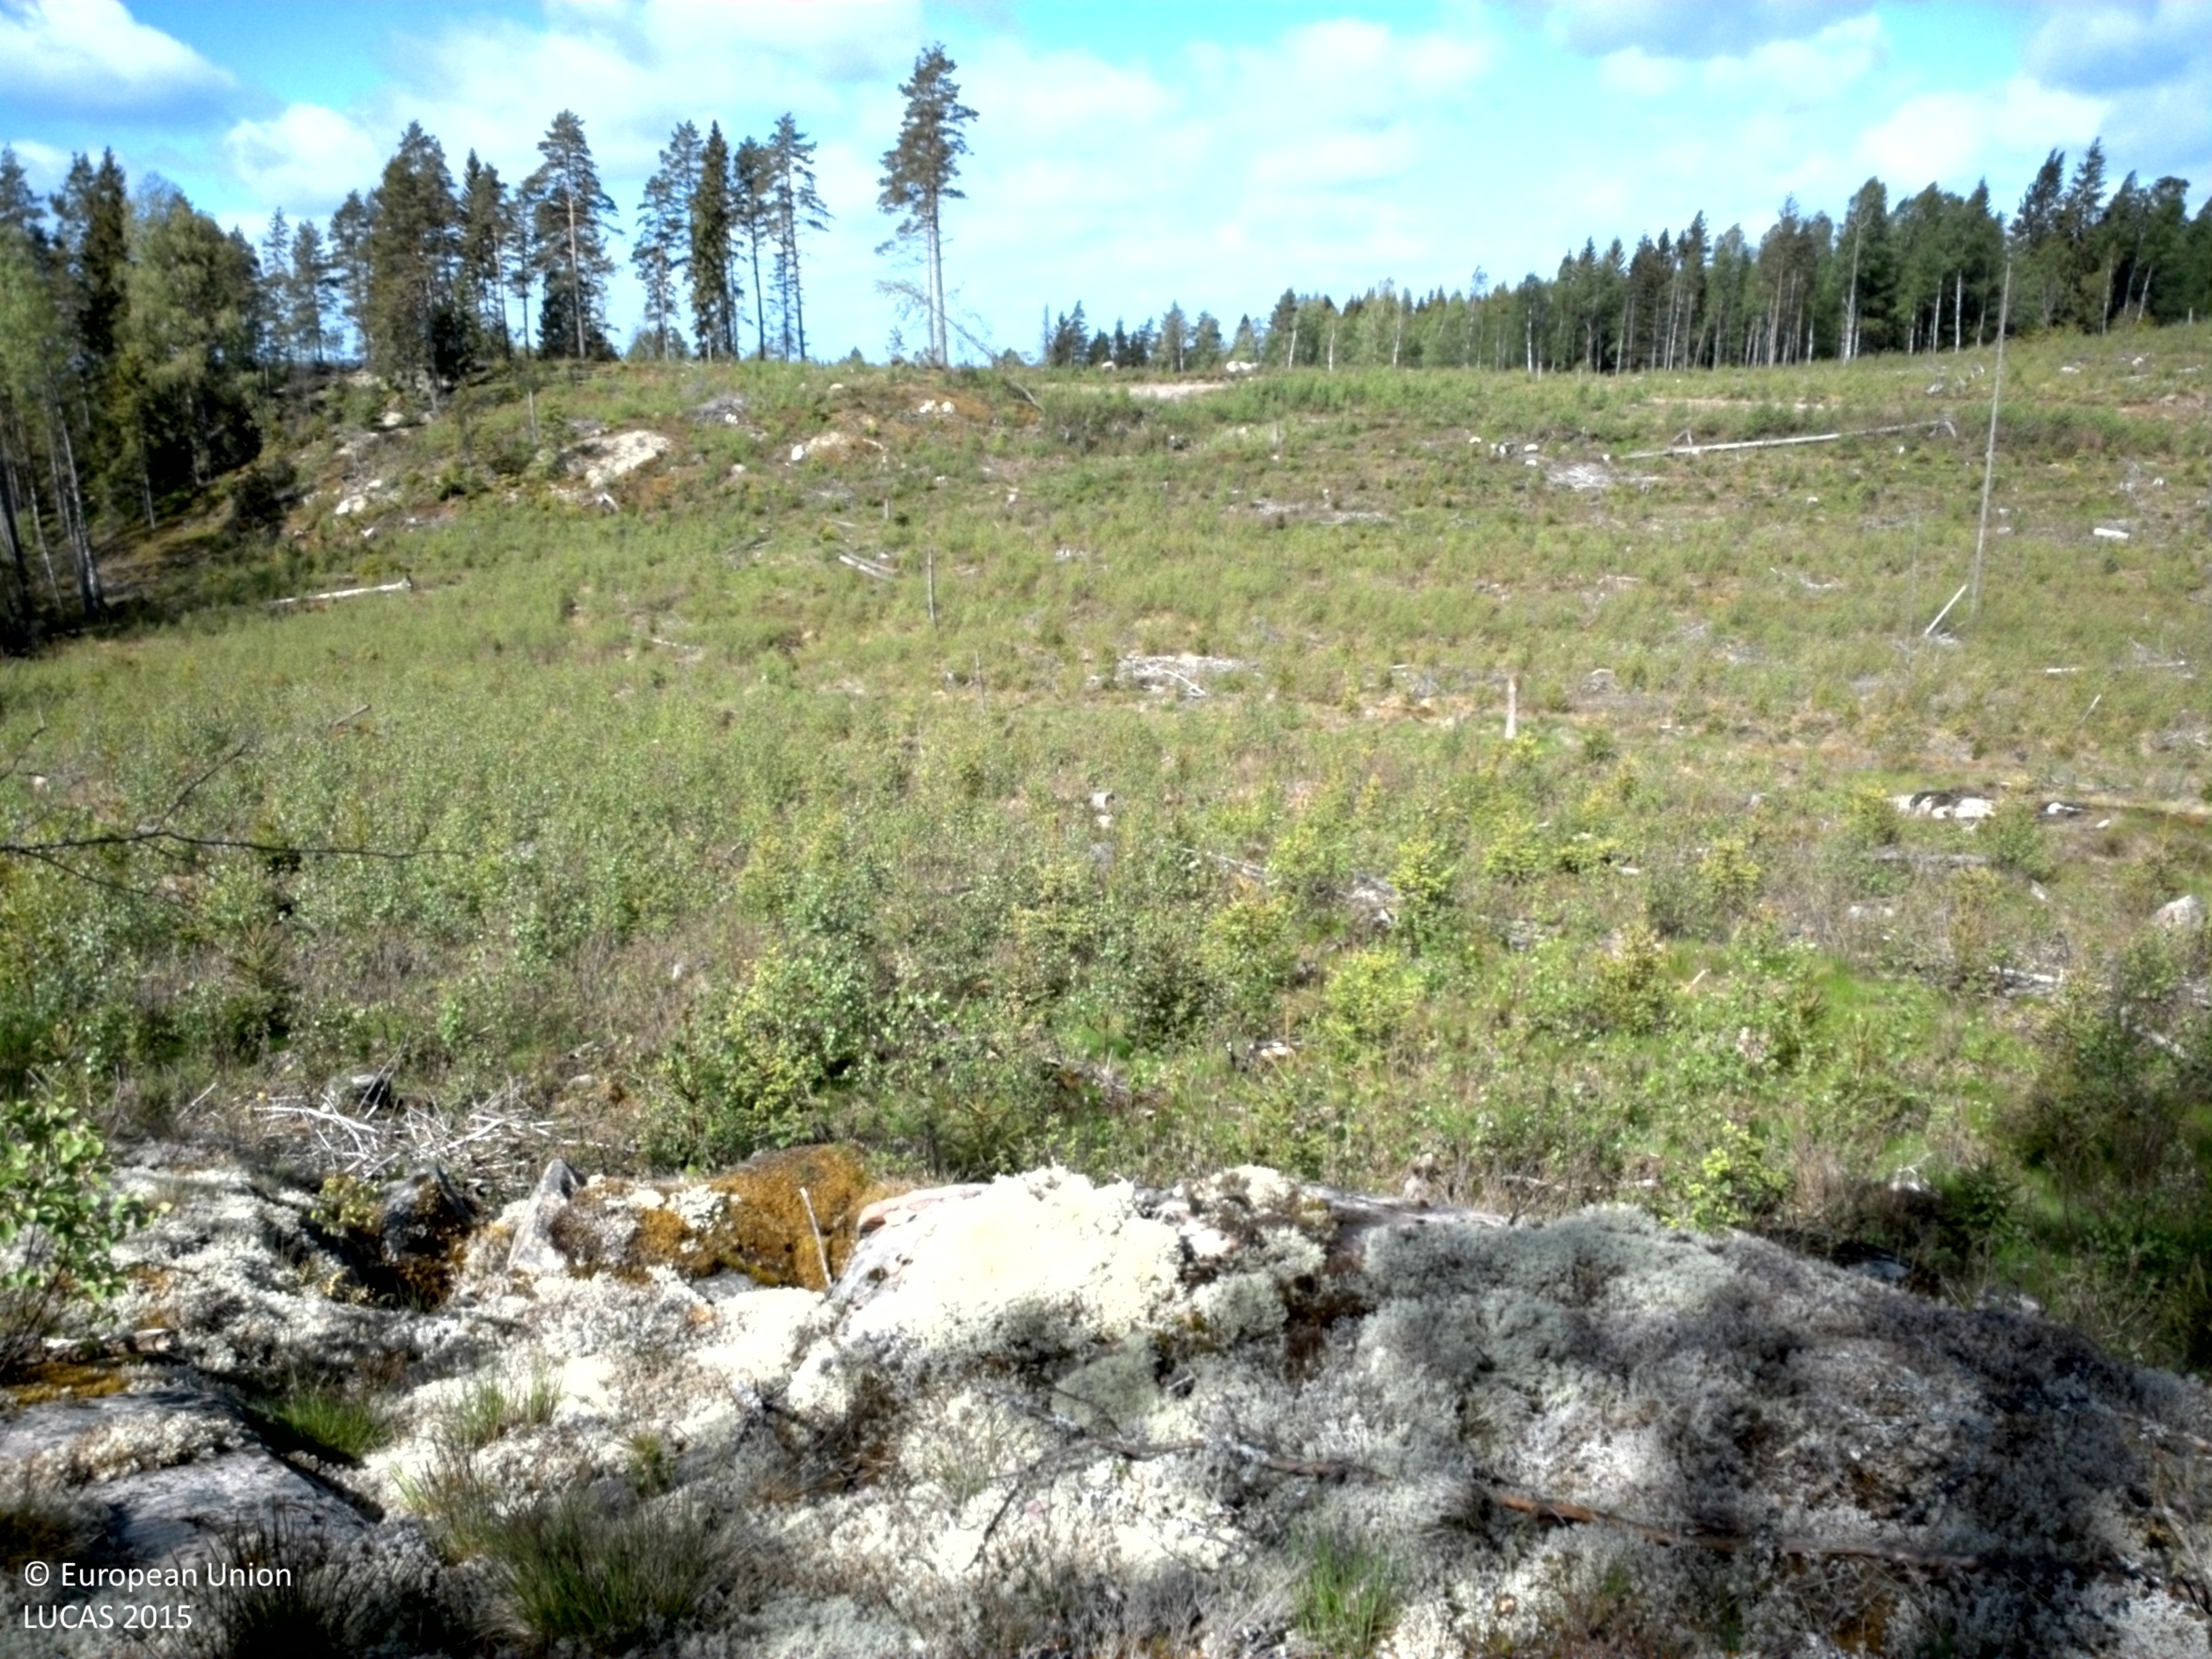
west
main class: Shrubland
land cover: Shrubland with sparse tree cover
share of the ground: 50 - 75 %
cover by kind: shrubs 50 %, lichens and mosses 25 %, herbaceous plants 20 %, coniferous forest trees 5 %
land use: Forestry
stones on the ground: 25 - 50 %
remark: Clear cut
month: June
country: SE
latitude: 59.3325
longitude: 12.3671
